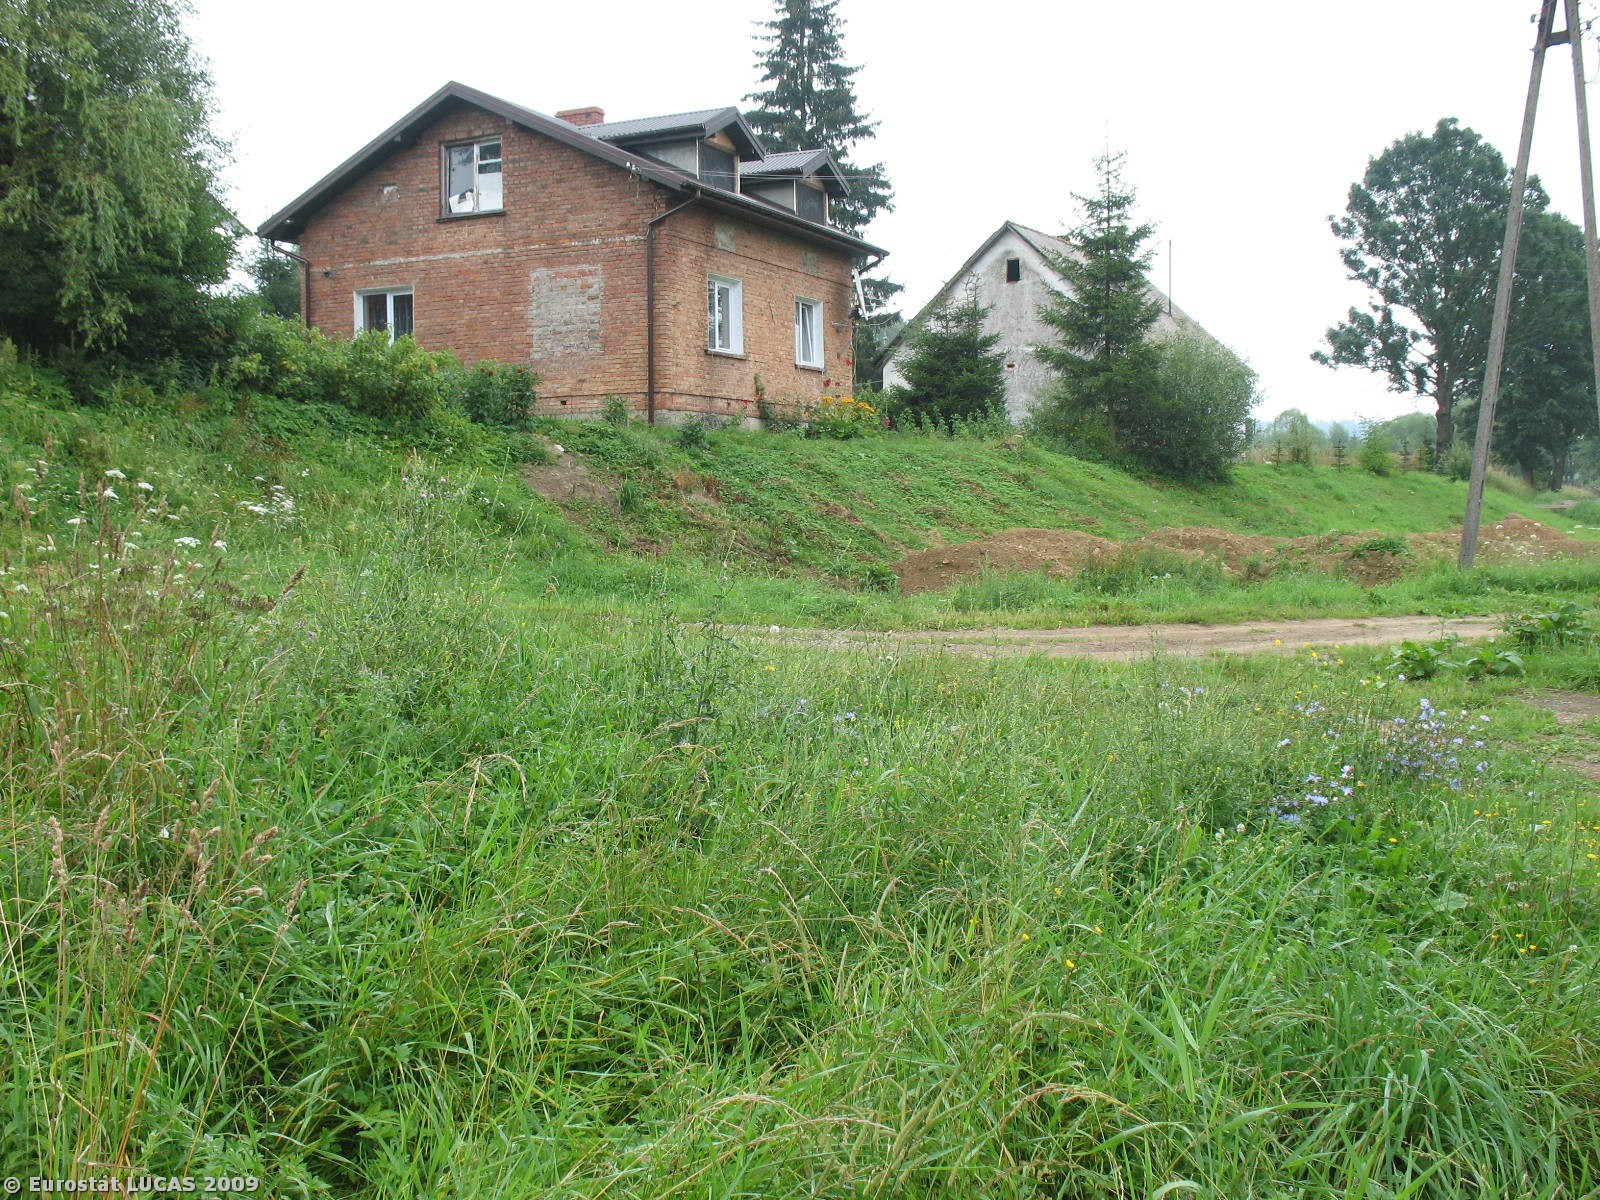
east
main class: Grassland
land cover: Spontaneously vegetated surfaces
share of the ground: > 75 %
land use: Unused
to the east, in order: Spontaneously vegetated surfaces; Tracks; Grassland without tree/shrub cover; Artificial constructions in urban areas; Spontaneously vegetated surfaces; Fences; Artificial constructions in urban areas; Fences; Tracks; Spontaneously vegetated surfaces; Broadleaved woodland; Ditches and canals; Grassland without tree/shrub cover
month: May
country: PL
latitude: 49.4658
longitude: 22.5807
